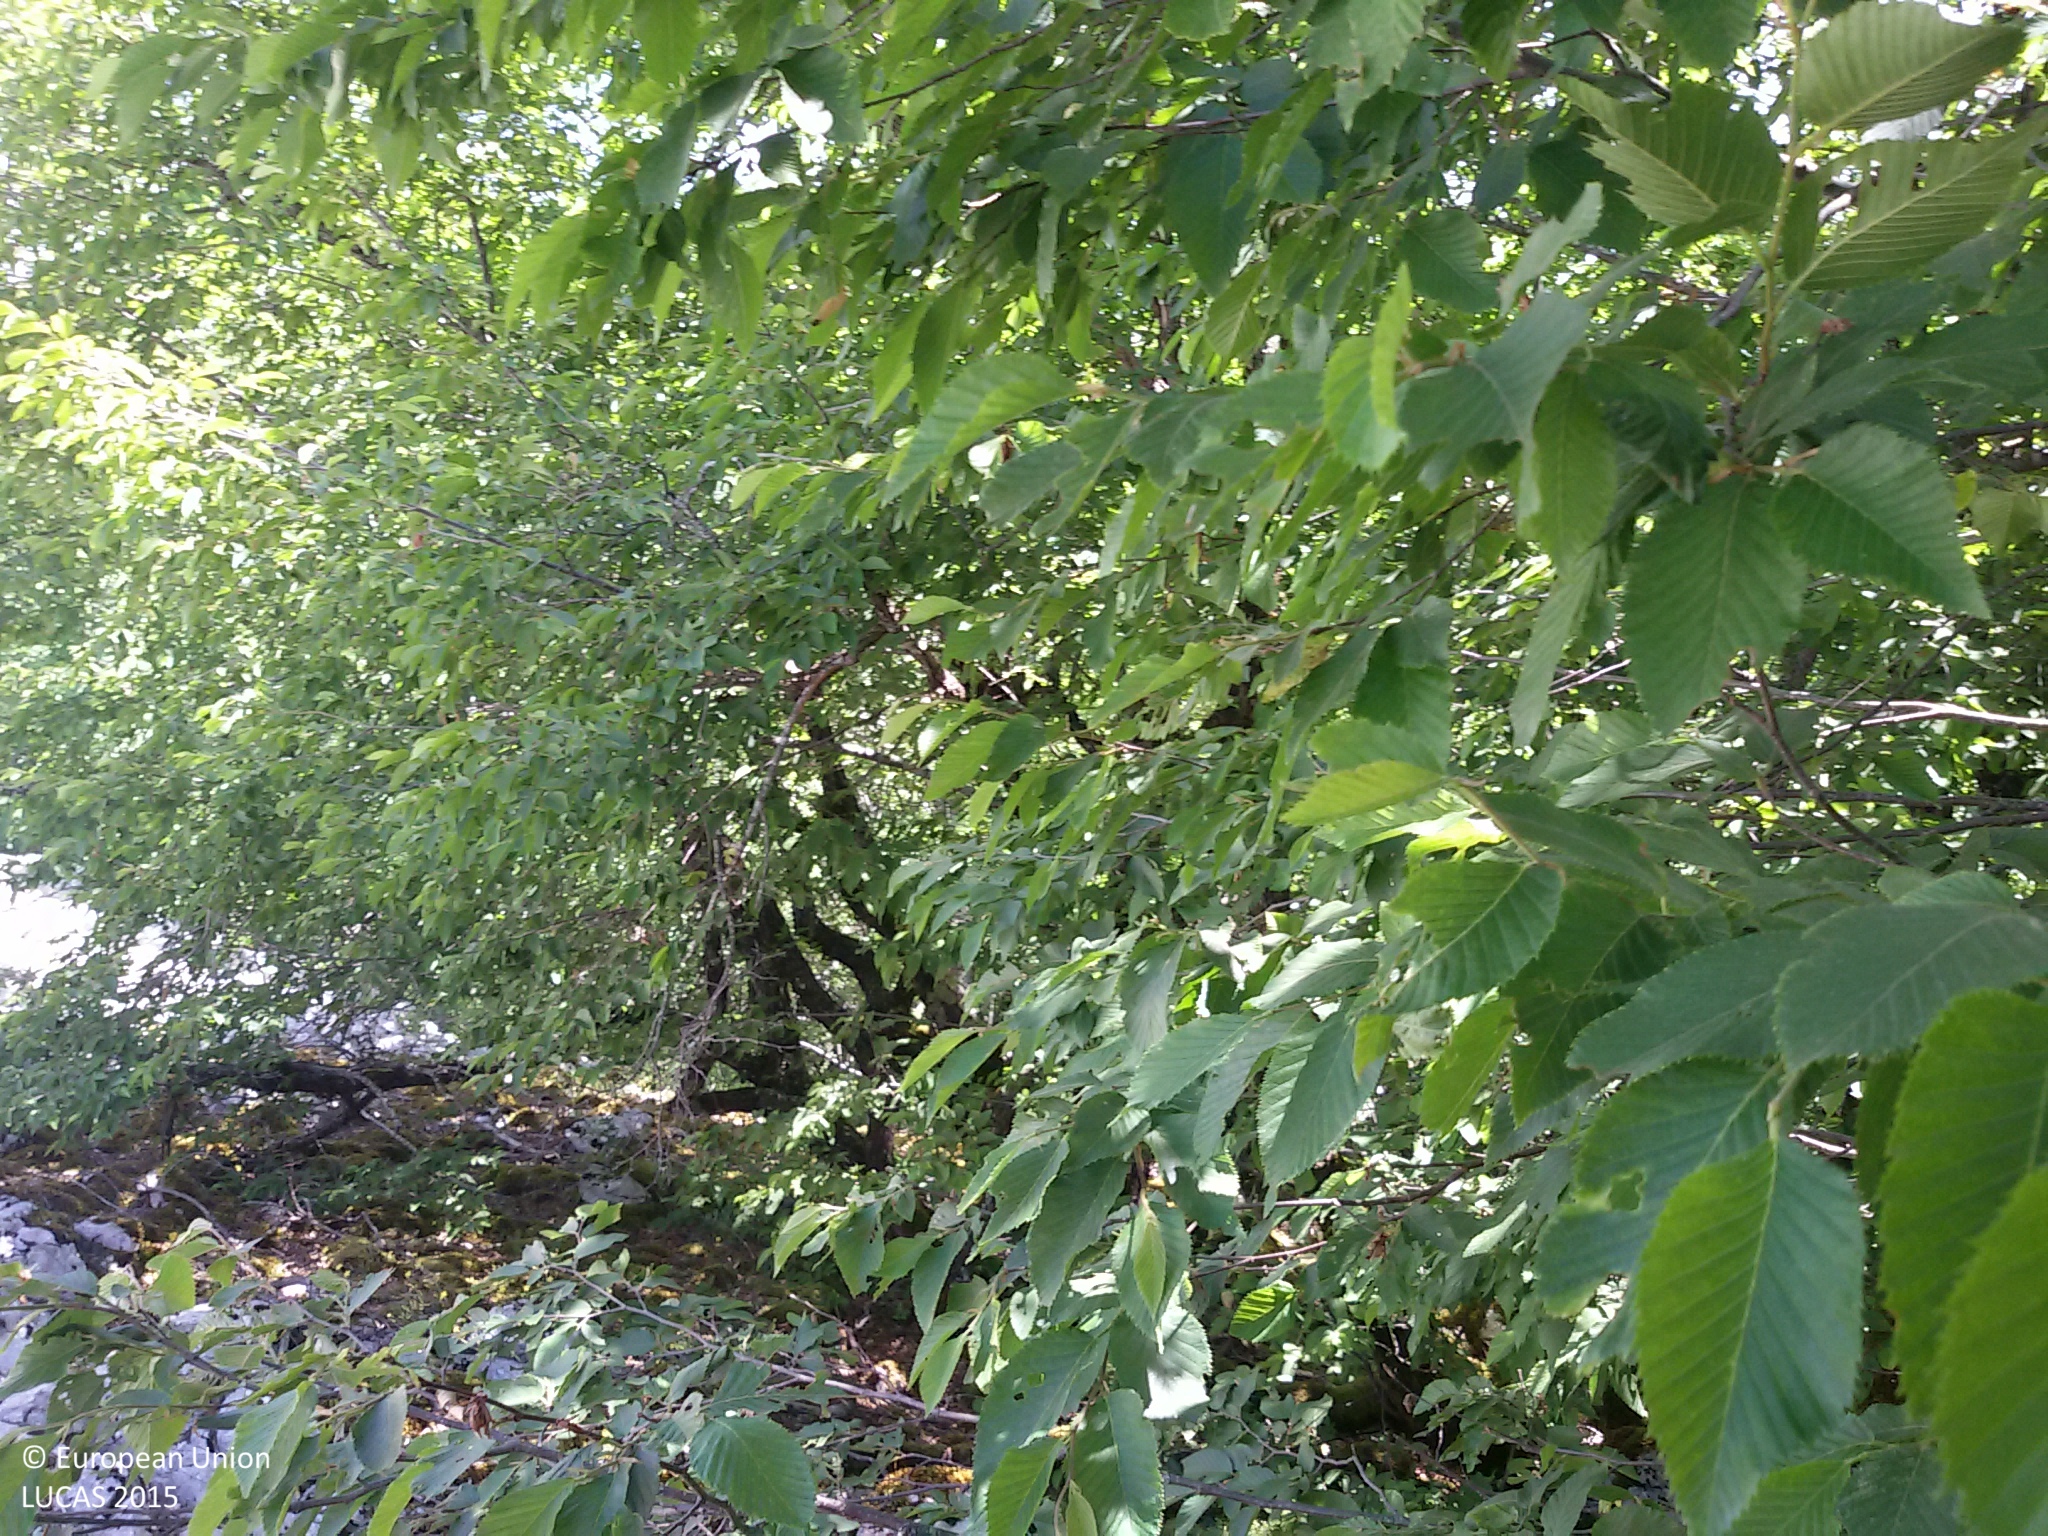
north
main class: Woodland
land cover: Broadleaved woodland
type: mountainous beech forest
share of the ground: 50 - 75 %
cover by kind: broadleaved forest trees 50 %, consolidated bare surface 20 %, shrubs 10 %, lichens and mosses 10 %, herbaceous plants 5 %, unconsolidated bare surface 5 %
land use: Semi-natural and natural areas not in use
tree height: > 5 m
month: June
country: HR
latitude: 44.5610
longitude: 15.5962
